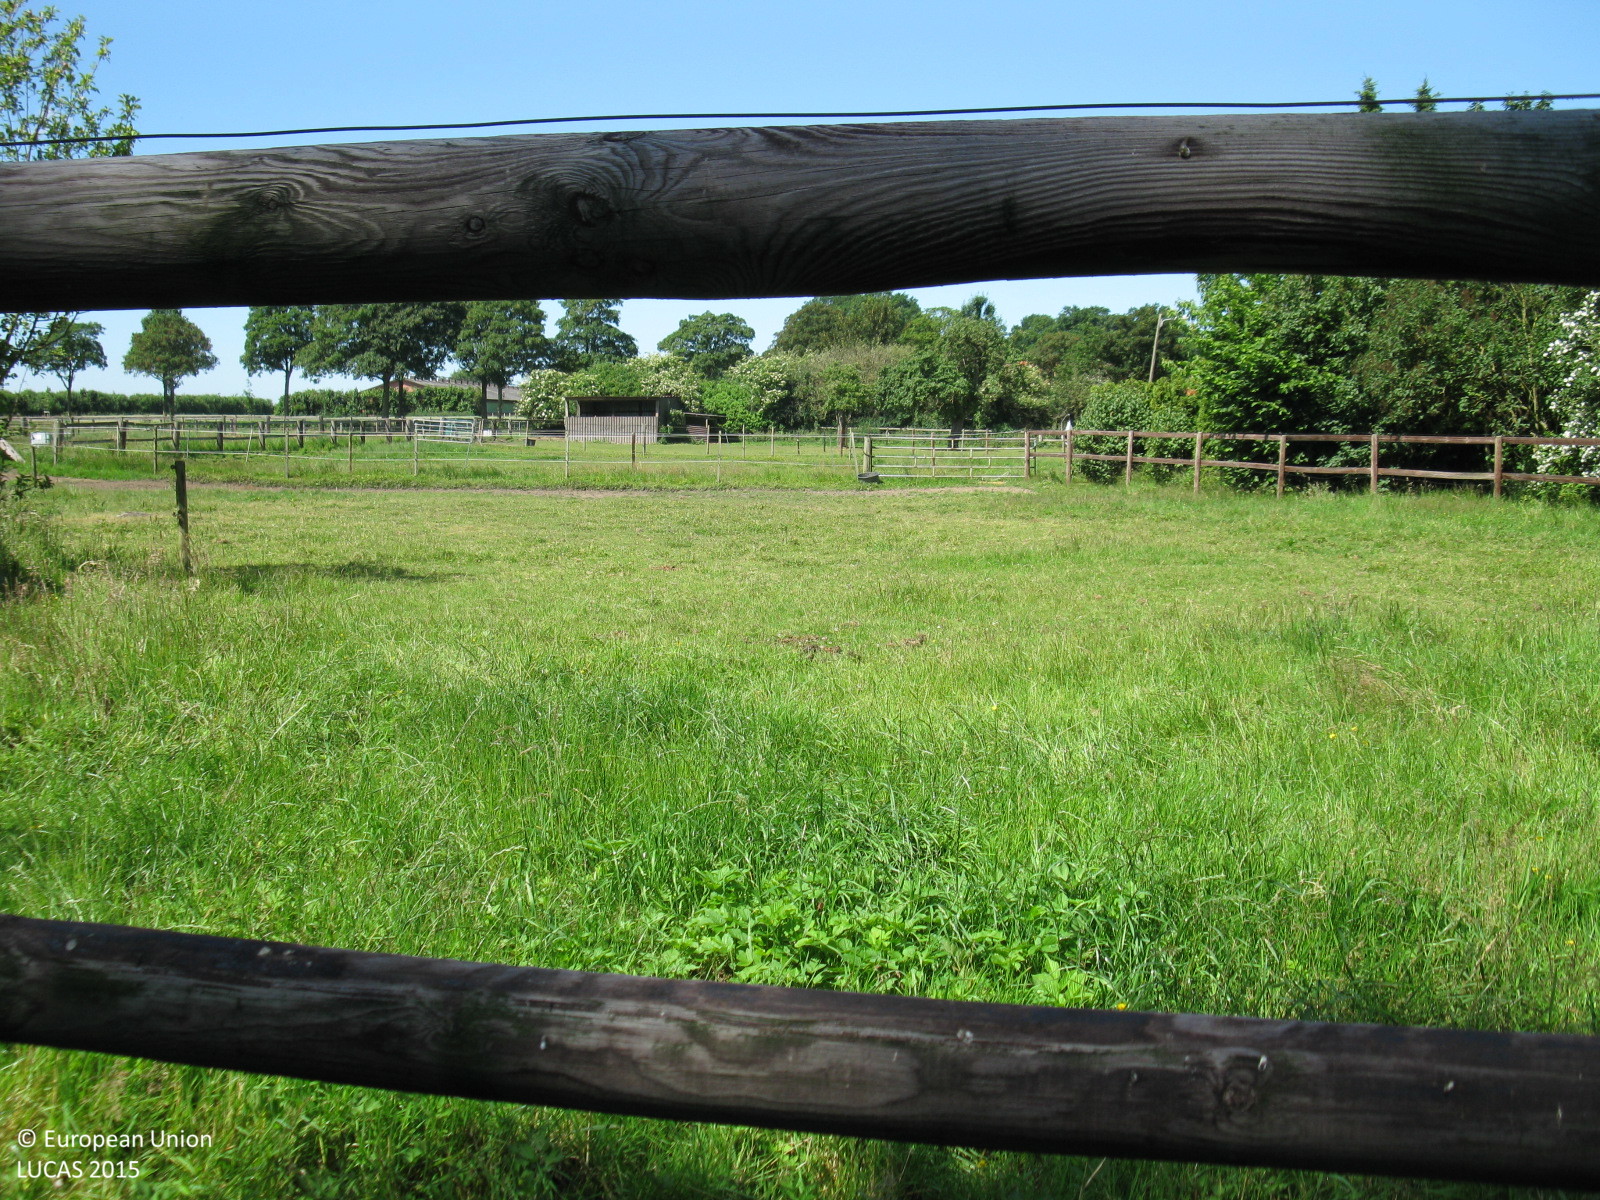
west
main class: Grassland
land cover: Grassland without tree/shrub cover
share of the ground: > 75 %
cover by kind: herbaceous plants 100 %
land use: Agriculture (excluding fallow land and kitchen gardens)
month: June
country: DE
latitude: 52.8717
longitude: 8.5297
